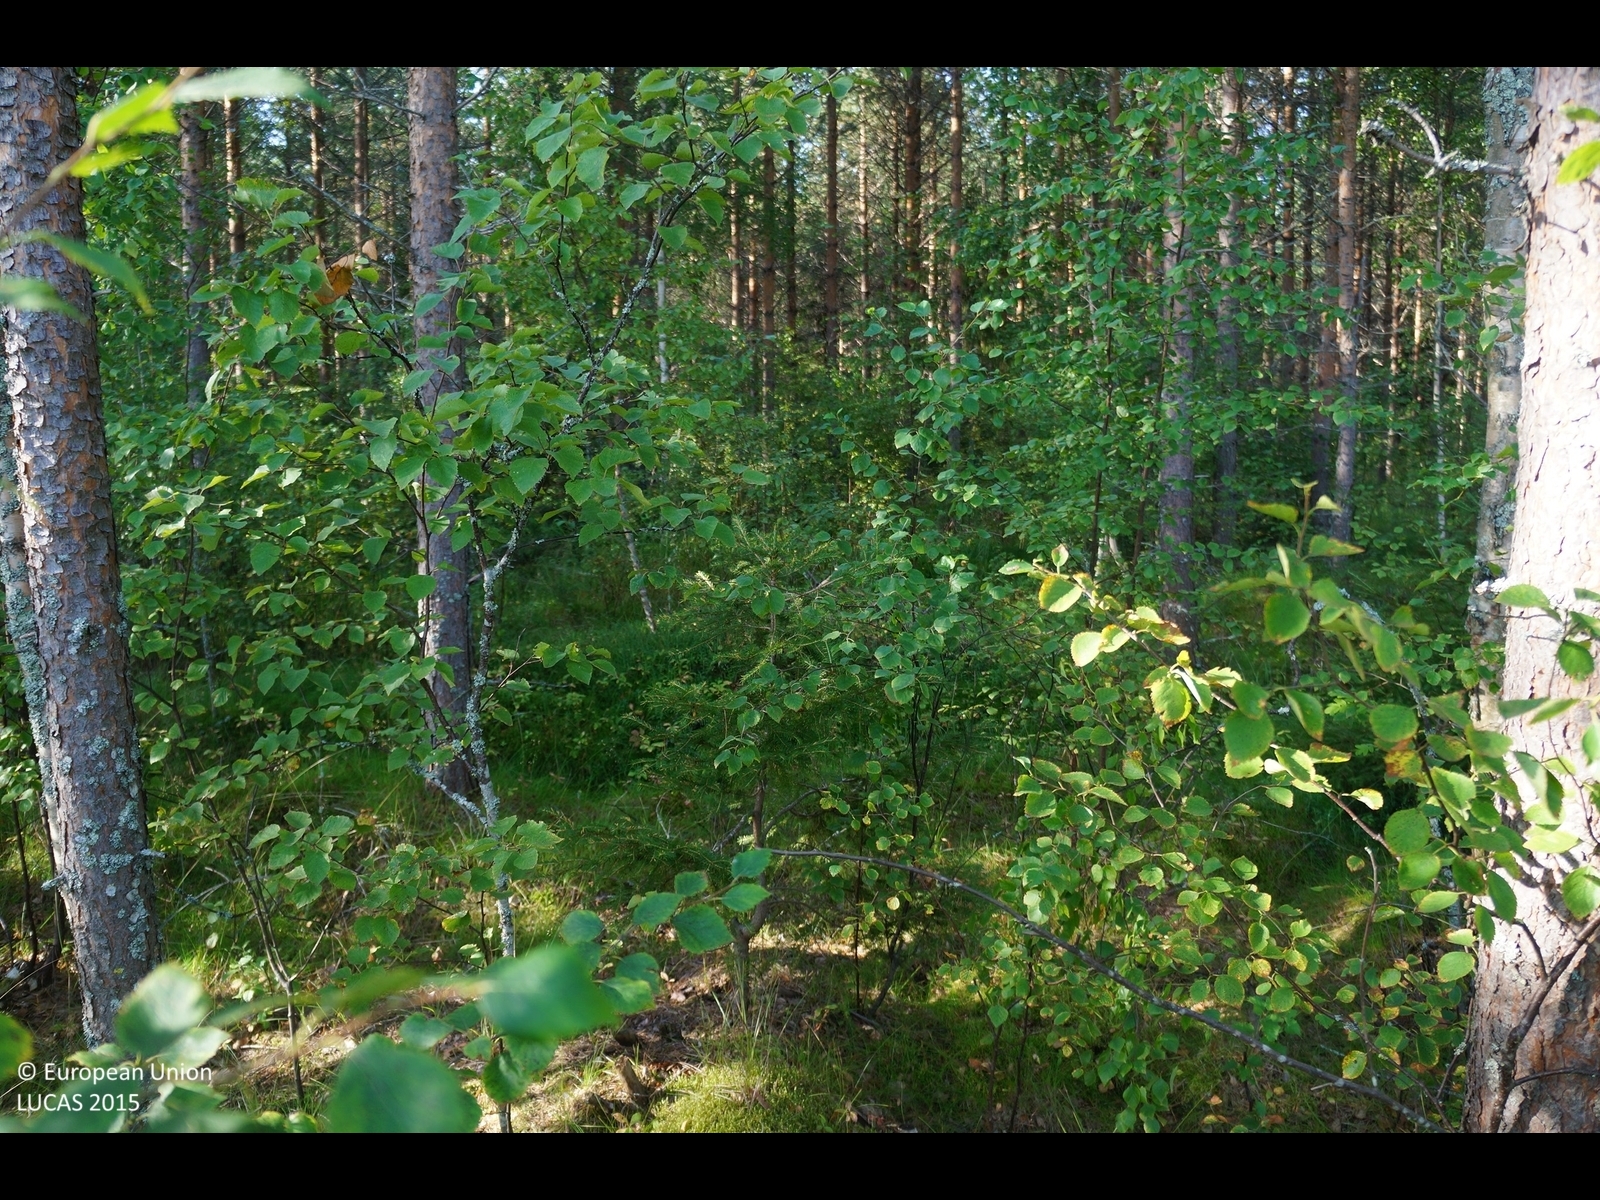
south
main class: Woodland
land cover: Pine dominated coniferous woodland
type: boreal forest
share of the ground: 50 - 75 %
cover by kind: coniferous forest trees 50 %, shrubs 35 %, lichens and mosses 10 %, herbaceous plants 5 %
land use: Forestry
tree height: > 5 m
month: August
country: FI
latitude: 64.8757
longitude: 25.0415
